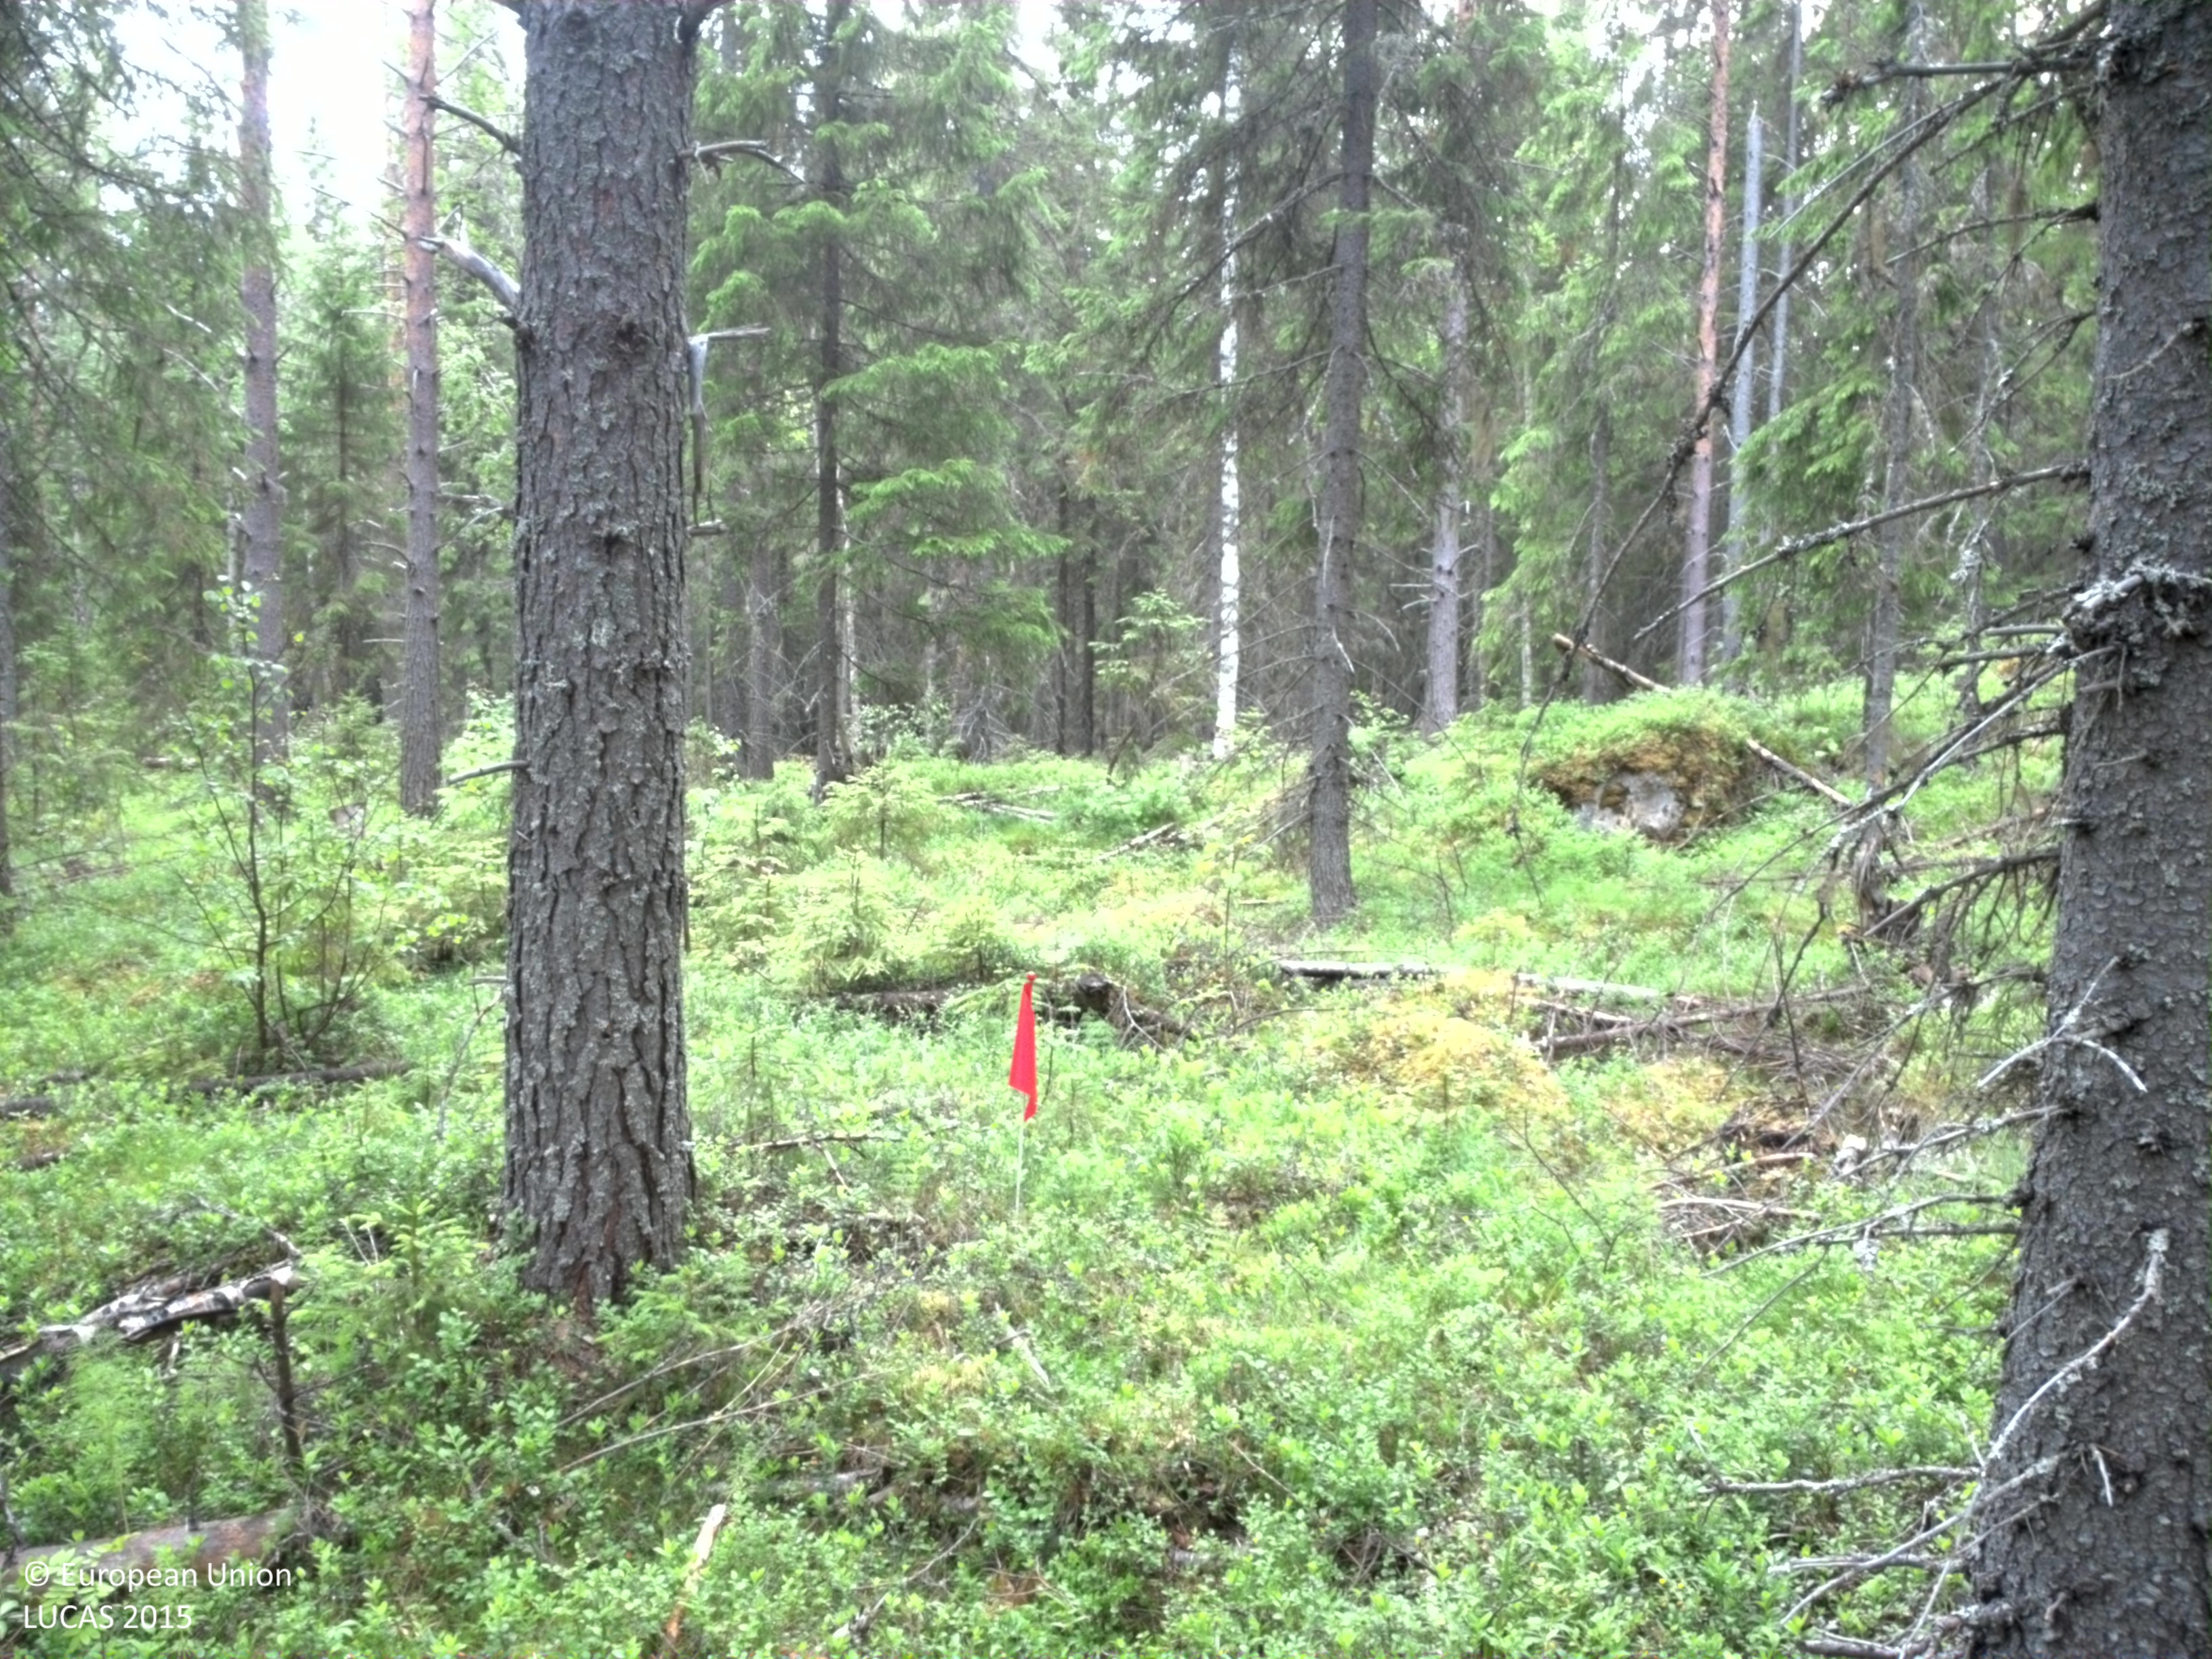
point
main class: Woodland
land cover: Spruce dominated coniferous woodland
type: boreal forest
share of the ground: 50 - 75 %
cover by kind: coniferous forest trees 45 %, shrubs 35 %, broadleaved forest trees 15 %, herbaceous plants 5 %
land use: Forestry
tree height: > 5 m
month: July
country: SE
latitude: 64.5346
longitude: 20.8814
